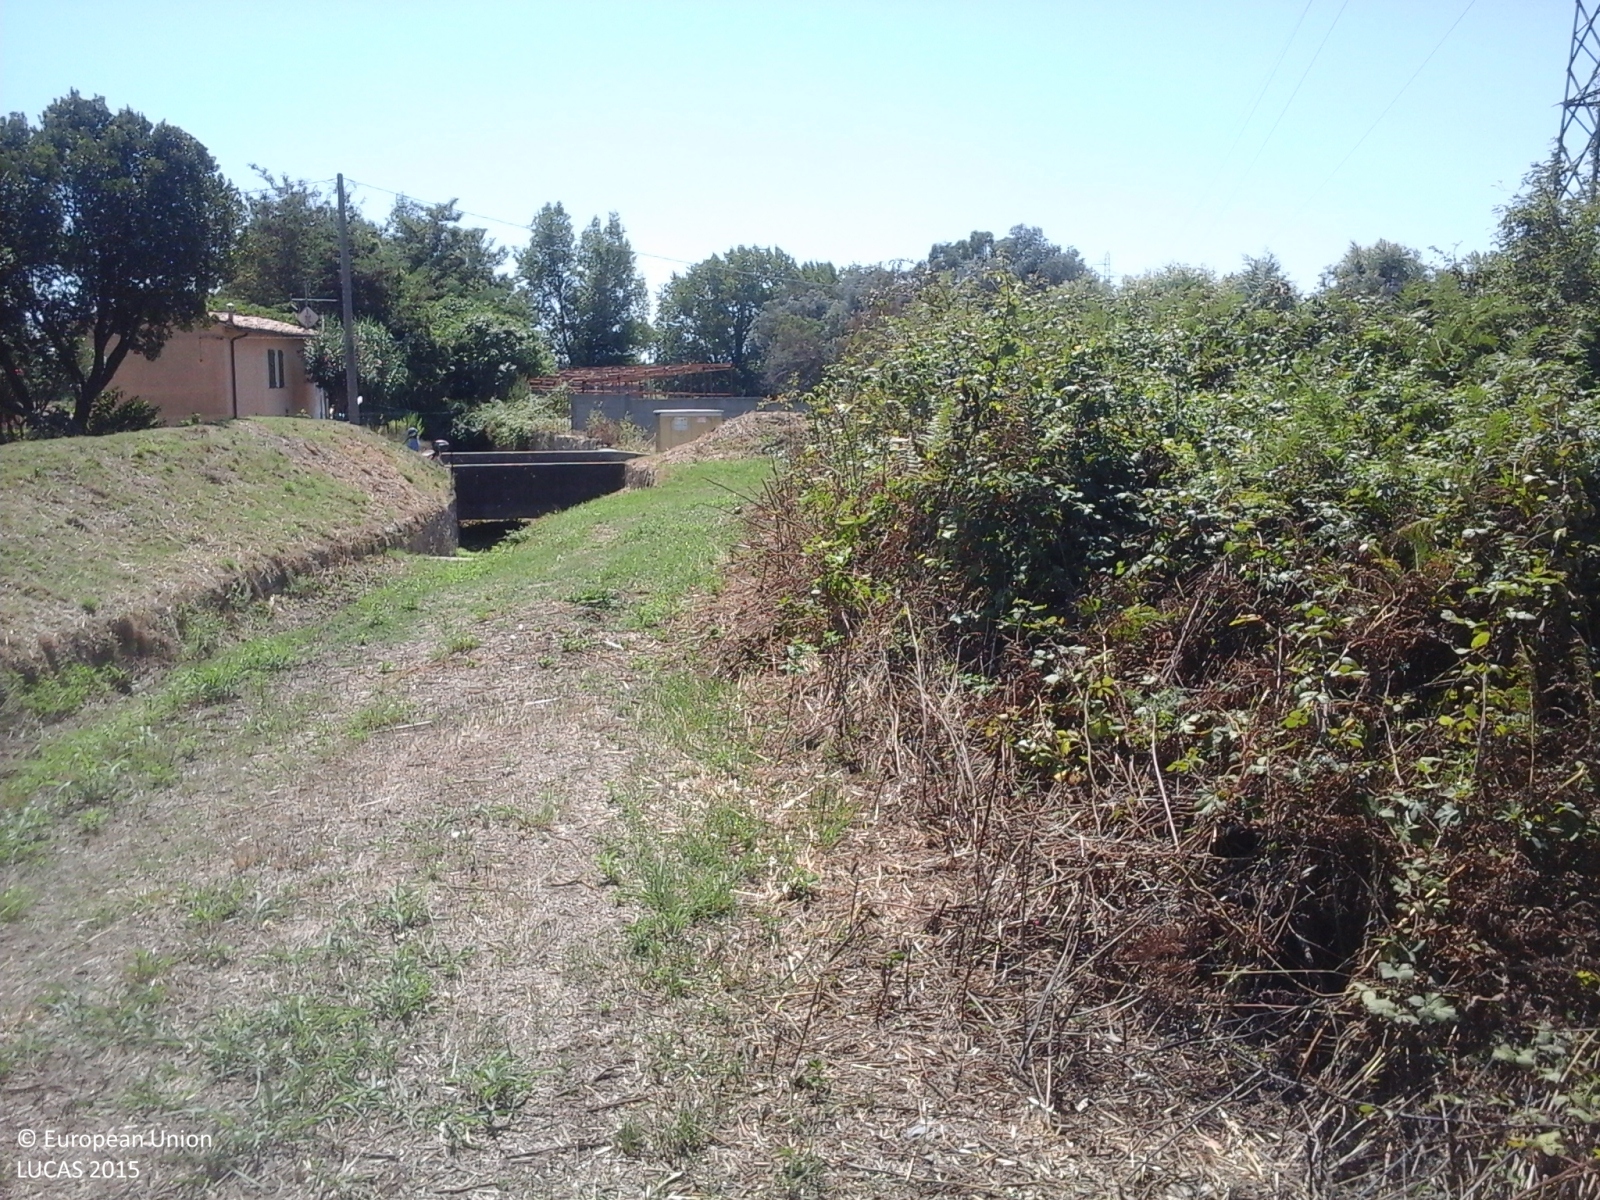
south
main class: Grassland
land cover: Grassland with sparse tree/shrub cover
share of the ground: > 75 %
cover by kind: herbaceous plants 85 %, shrubs 10 %, broadleaved forest trees 5 %
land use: Semi-natural and natural areas not in use
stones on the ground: < 10 %
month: August
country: IT
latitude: 43.7542
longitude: 10.4583
